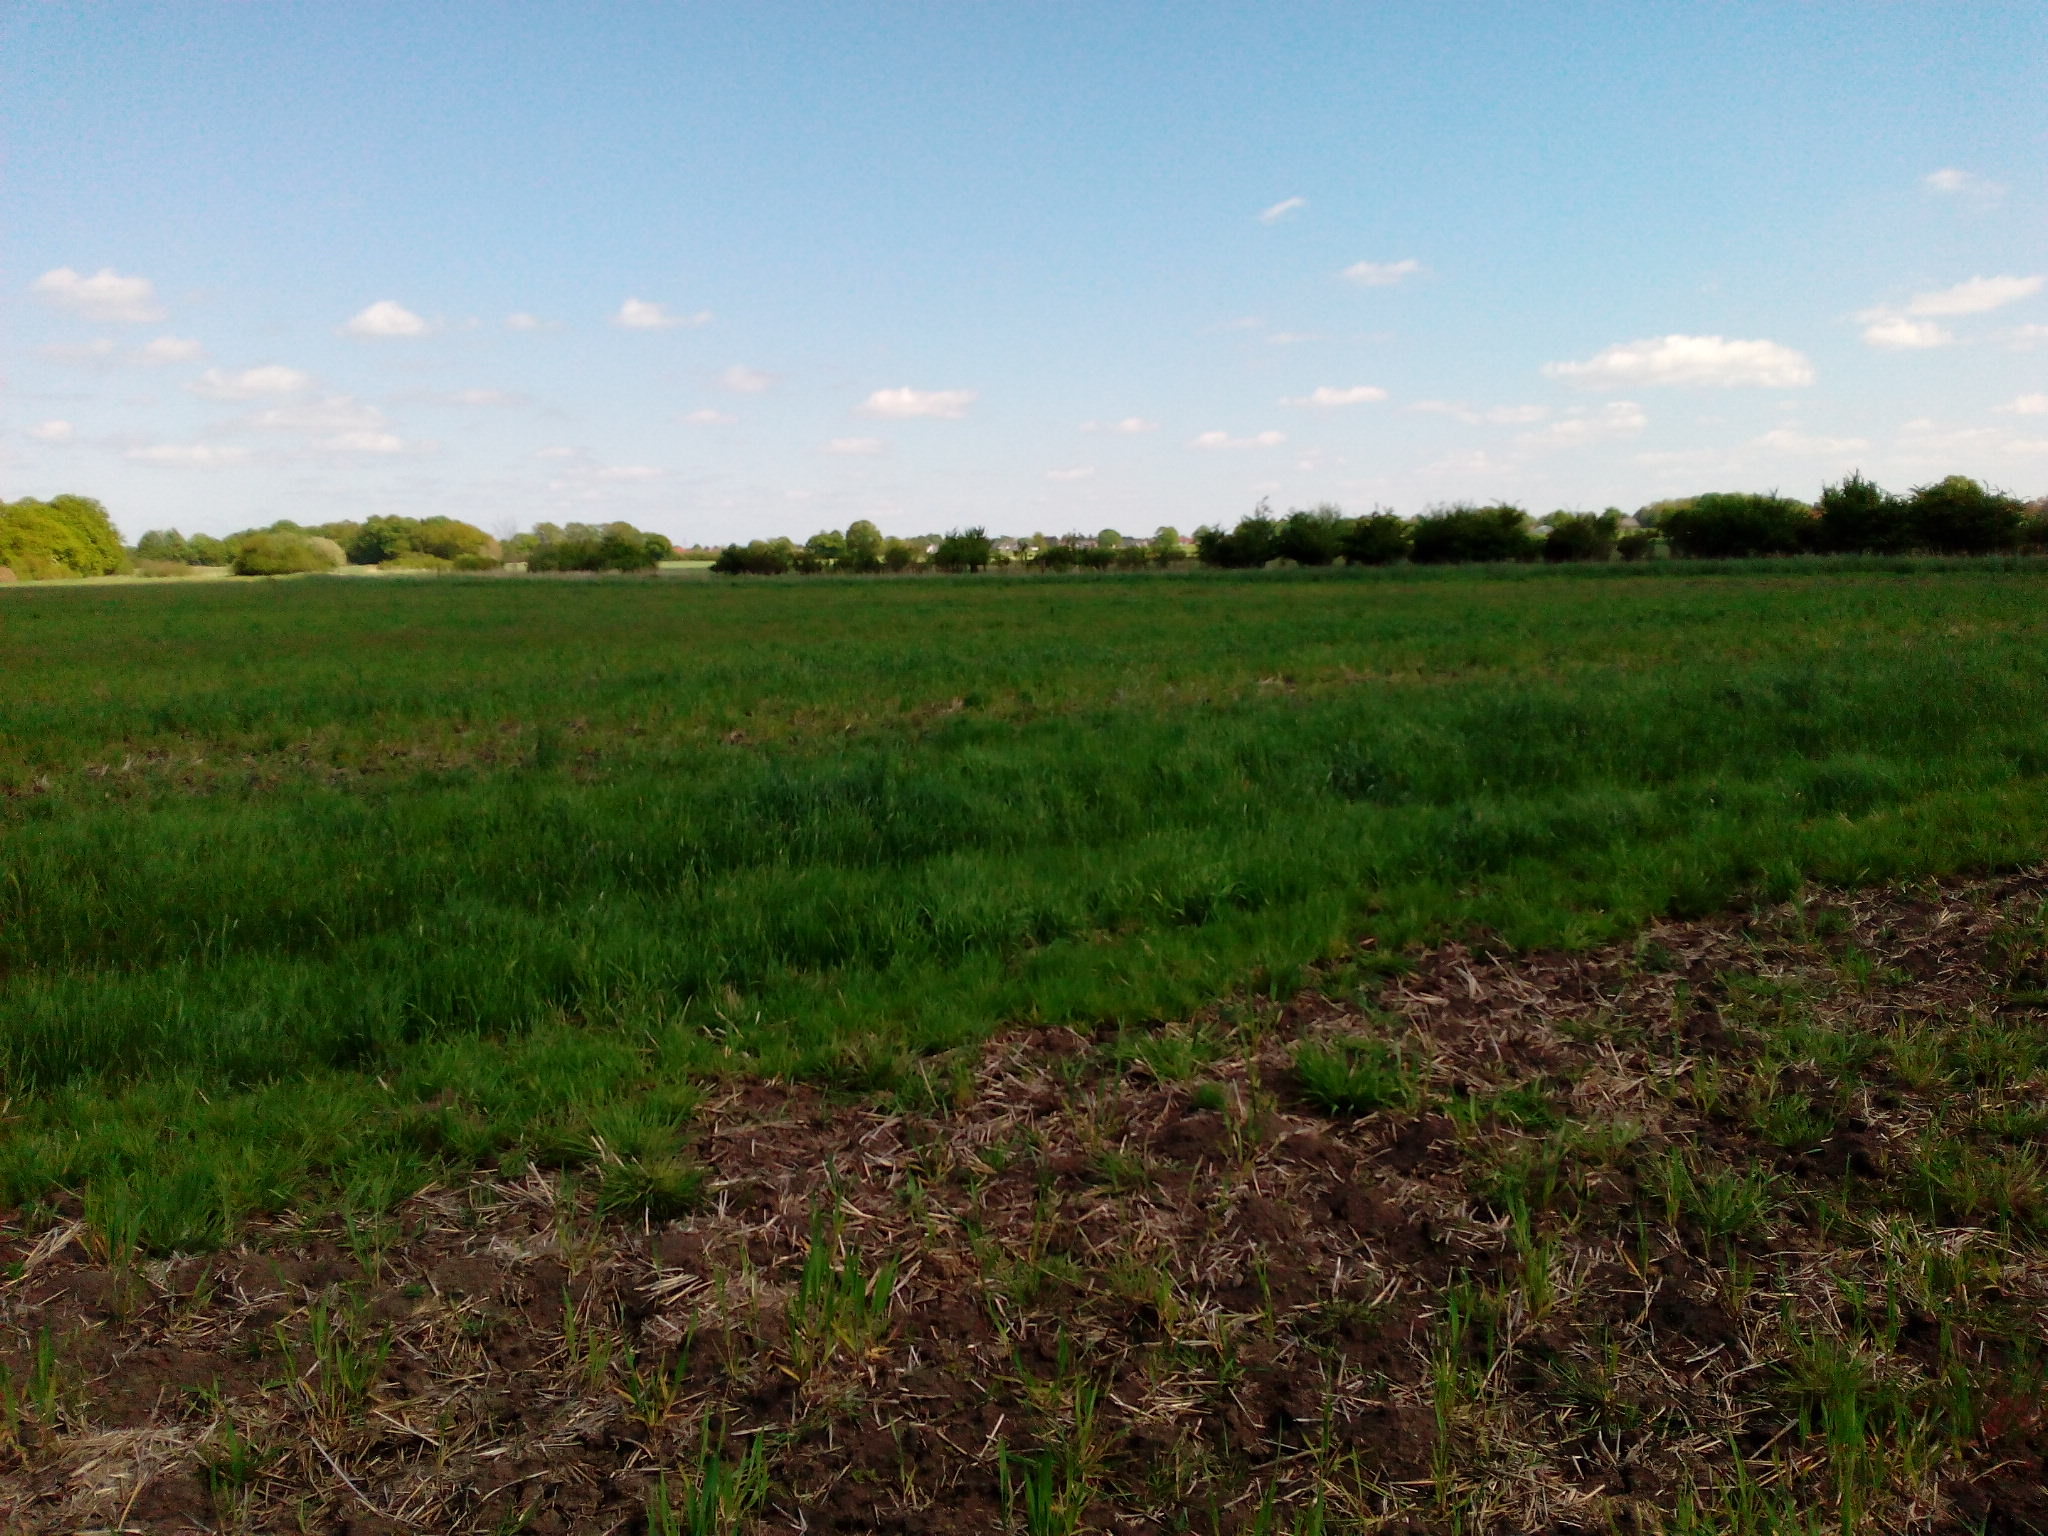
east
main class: Cropland
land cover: Triticale
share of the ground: < 10 %
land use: Agriculture (excluding fallow land and kitchen gardens)
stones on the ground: < 10 %
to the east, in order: Triticale; Grass margins; Ditches and canals; Grass margins; Triticale; Grass margins; Tracks; Grassland without tree/shrub cover; Ditches and canals; Grass margins; Shrubland without tree cover; Grassland without tree/shrub cover; Triticale
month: May
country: DE
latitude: 52.4493
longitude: 9.8676
